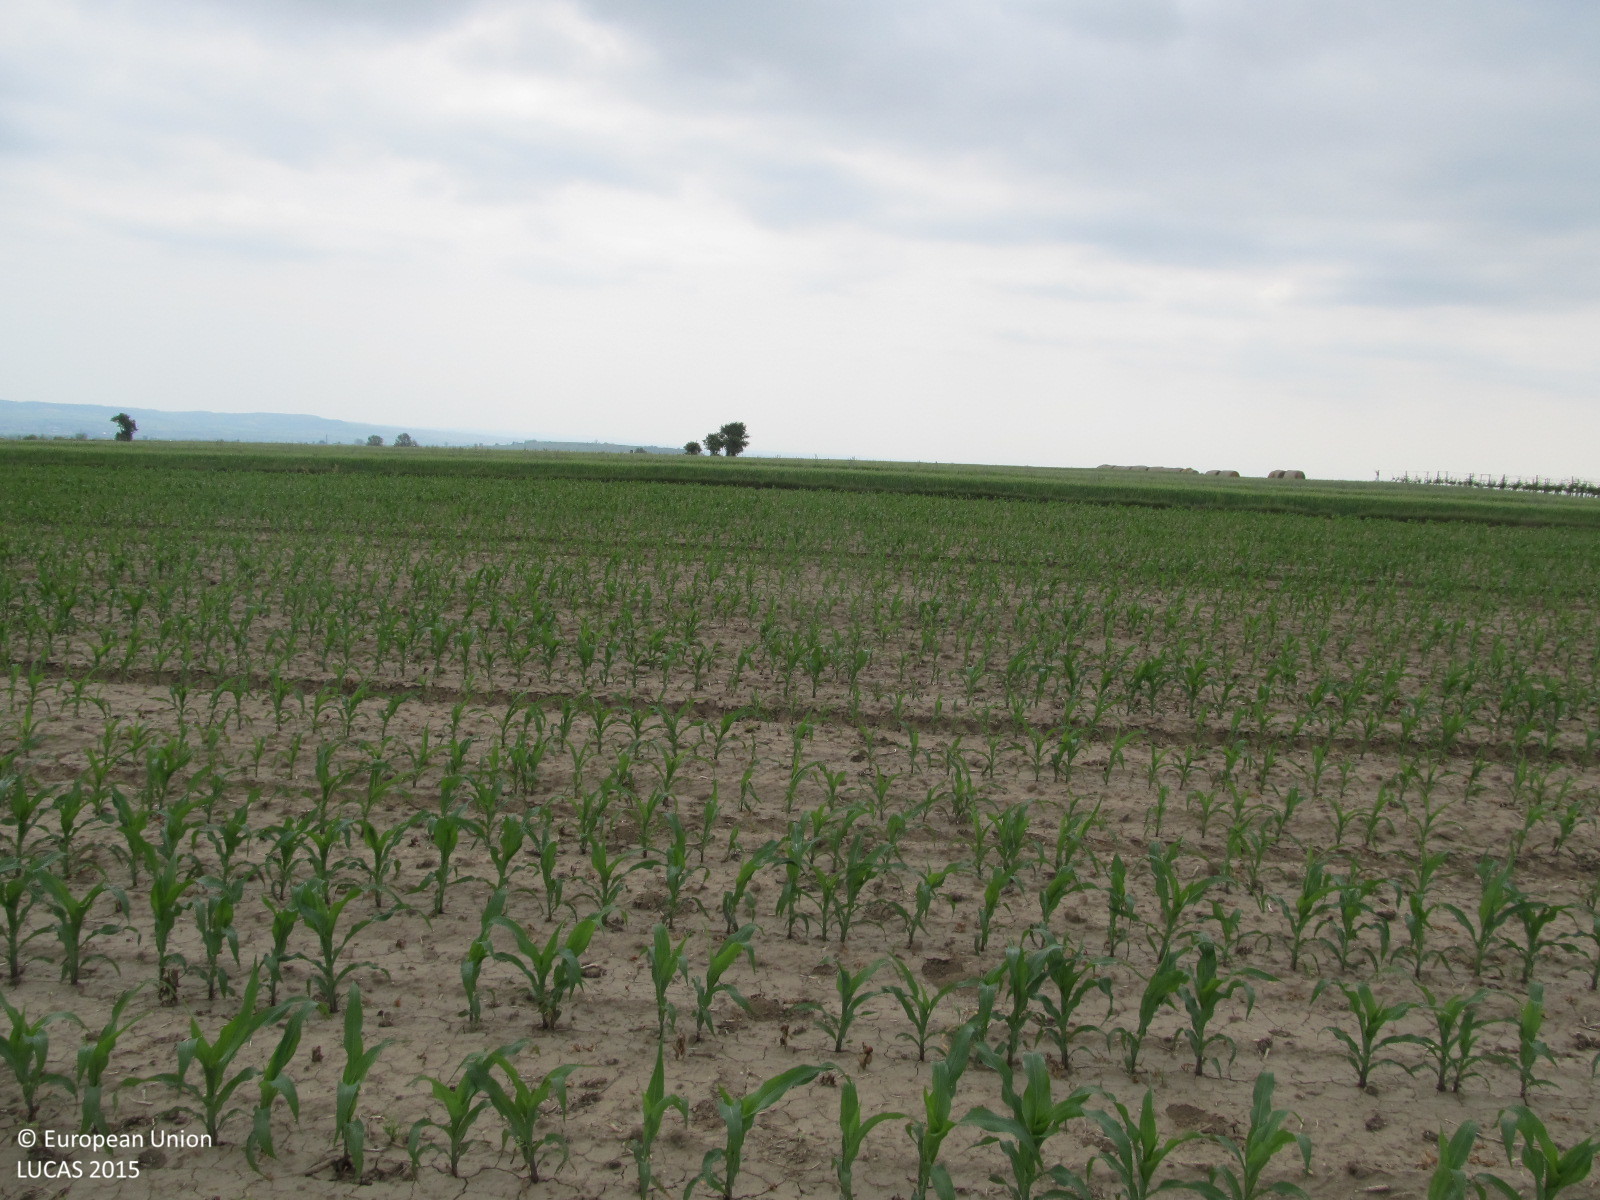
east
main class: Cropland
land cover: Maize
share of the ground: < 10 %
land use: Agriculture (excluding fallow land and kitchen gardens)
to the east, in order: Maize; Grass margins; Barley; Common wheat; Grass margins; Tracks
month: June
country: AT
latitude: 48.4399
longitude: 15.6400
